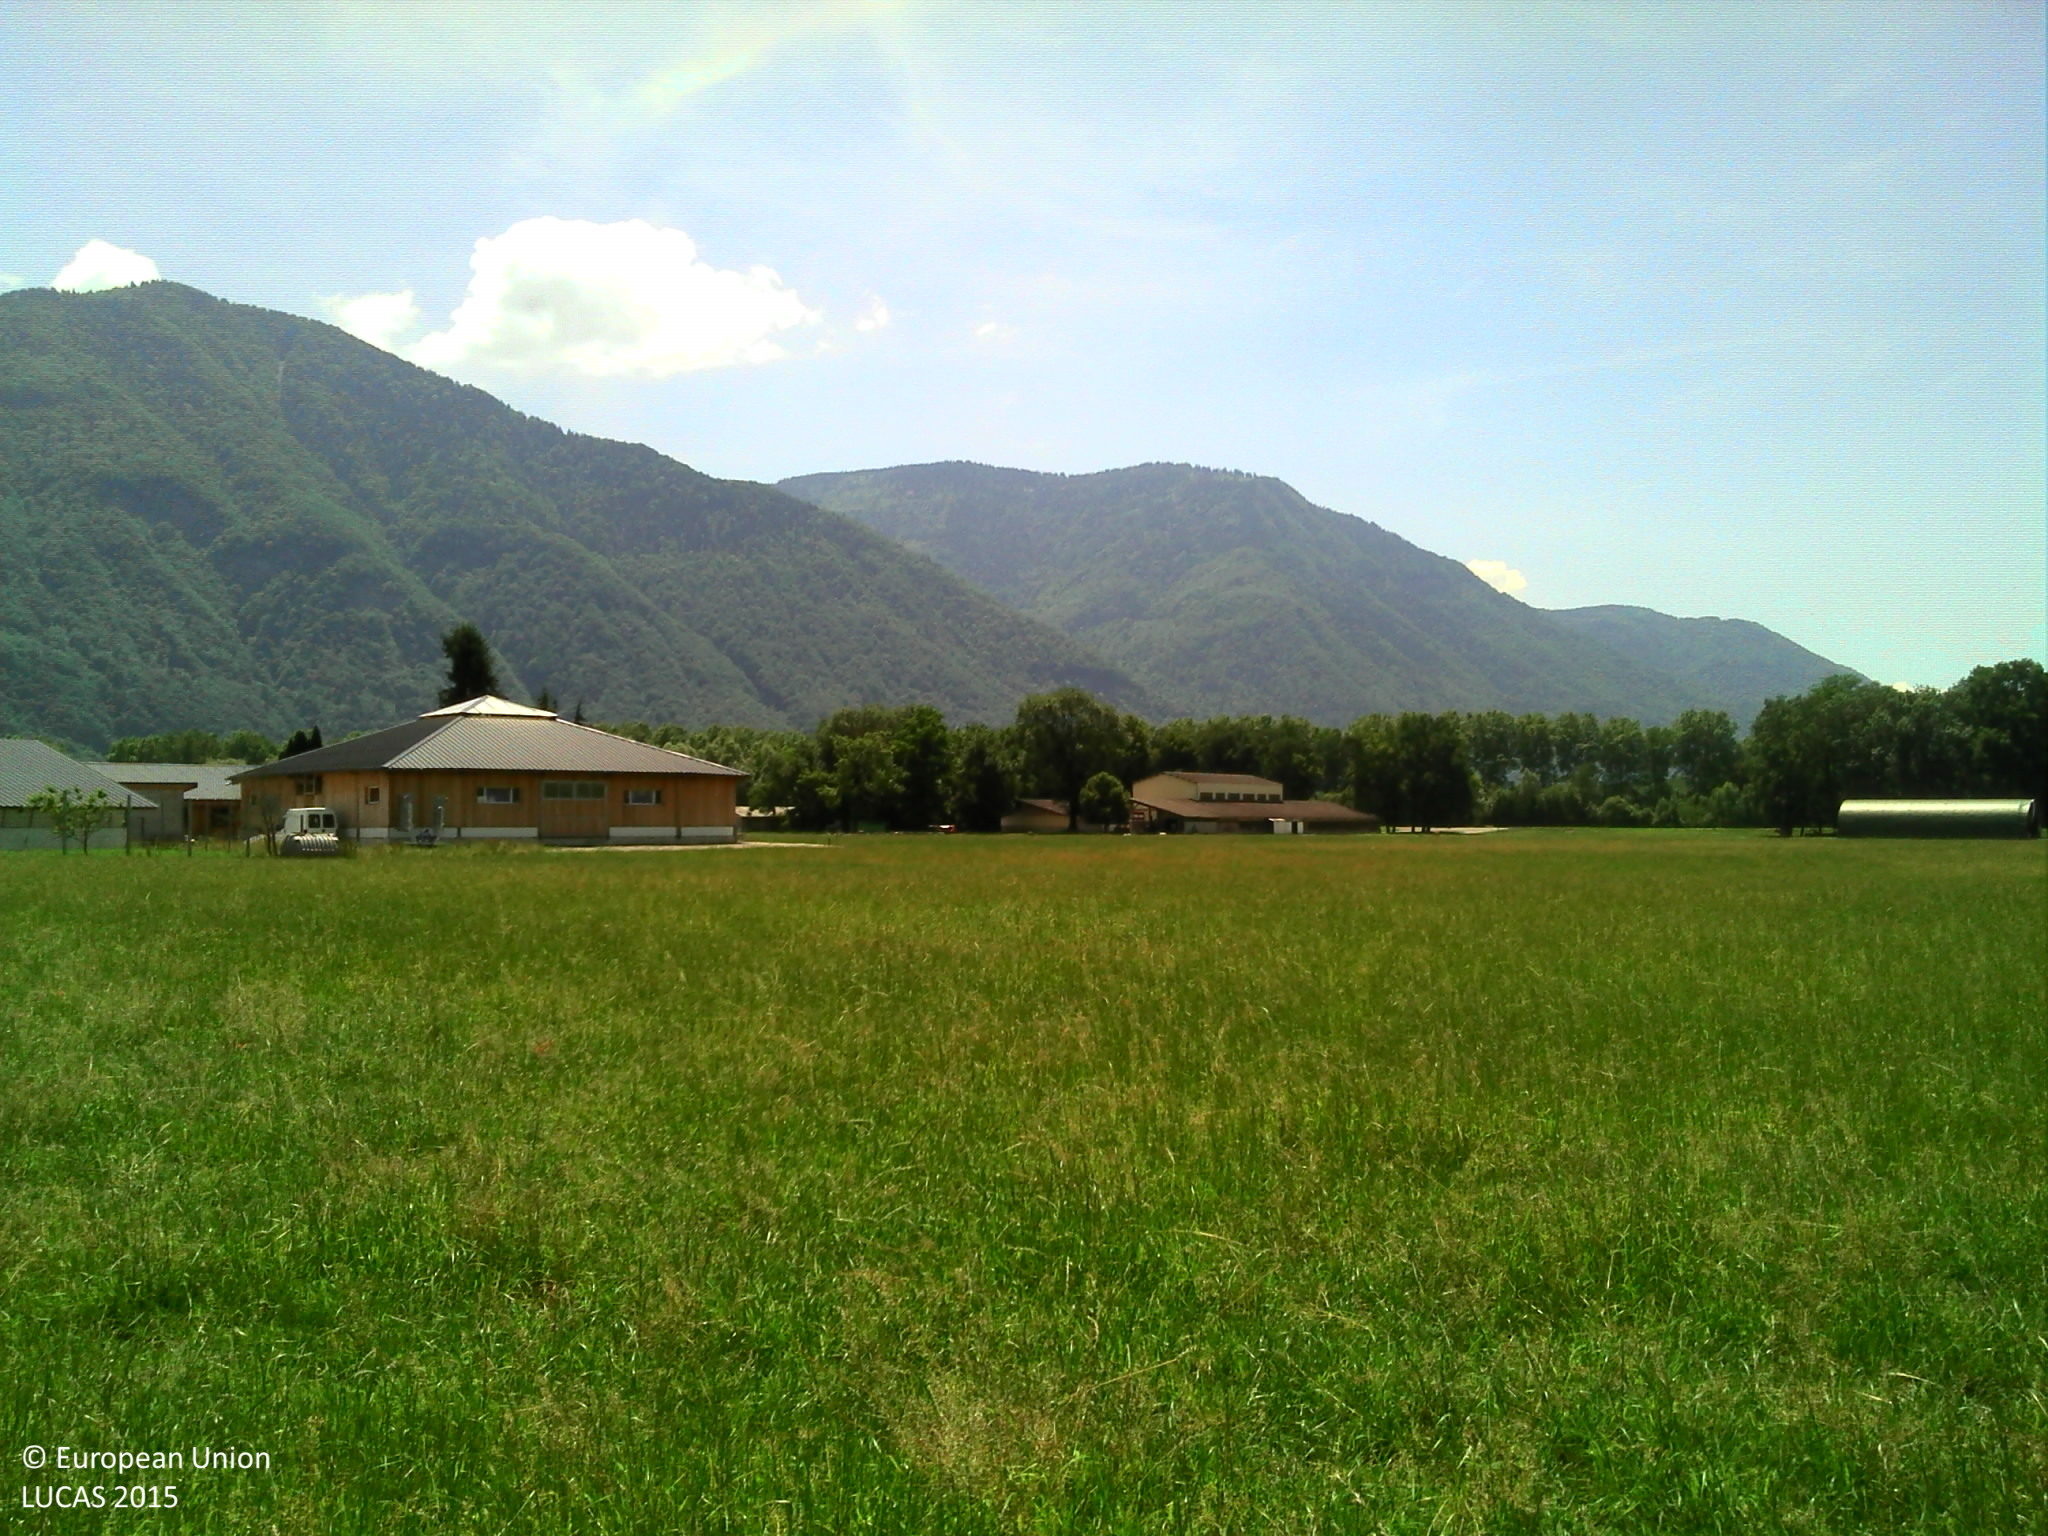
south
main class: Grassland
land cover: Grassland without tree/shrub cover
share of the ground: > 75 %
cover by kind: herbaceous plants 100 %
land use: Agriculture (excluding fallow land and kitchen gardens)
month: June
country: FR
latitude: 45.5632
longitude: 6.2250
